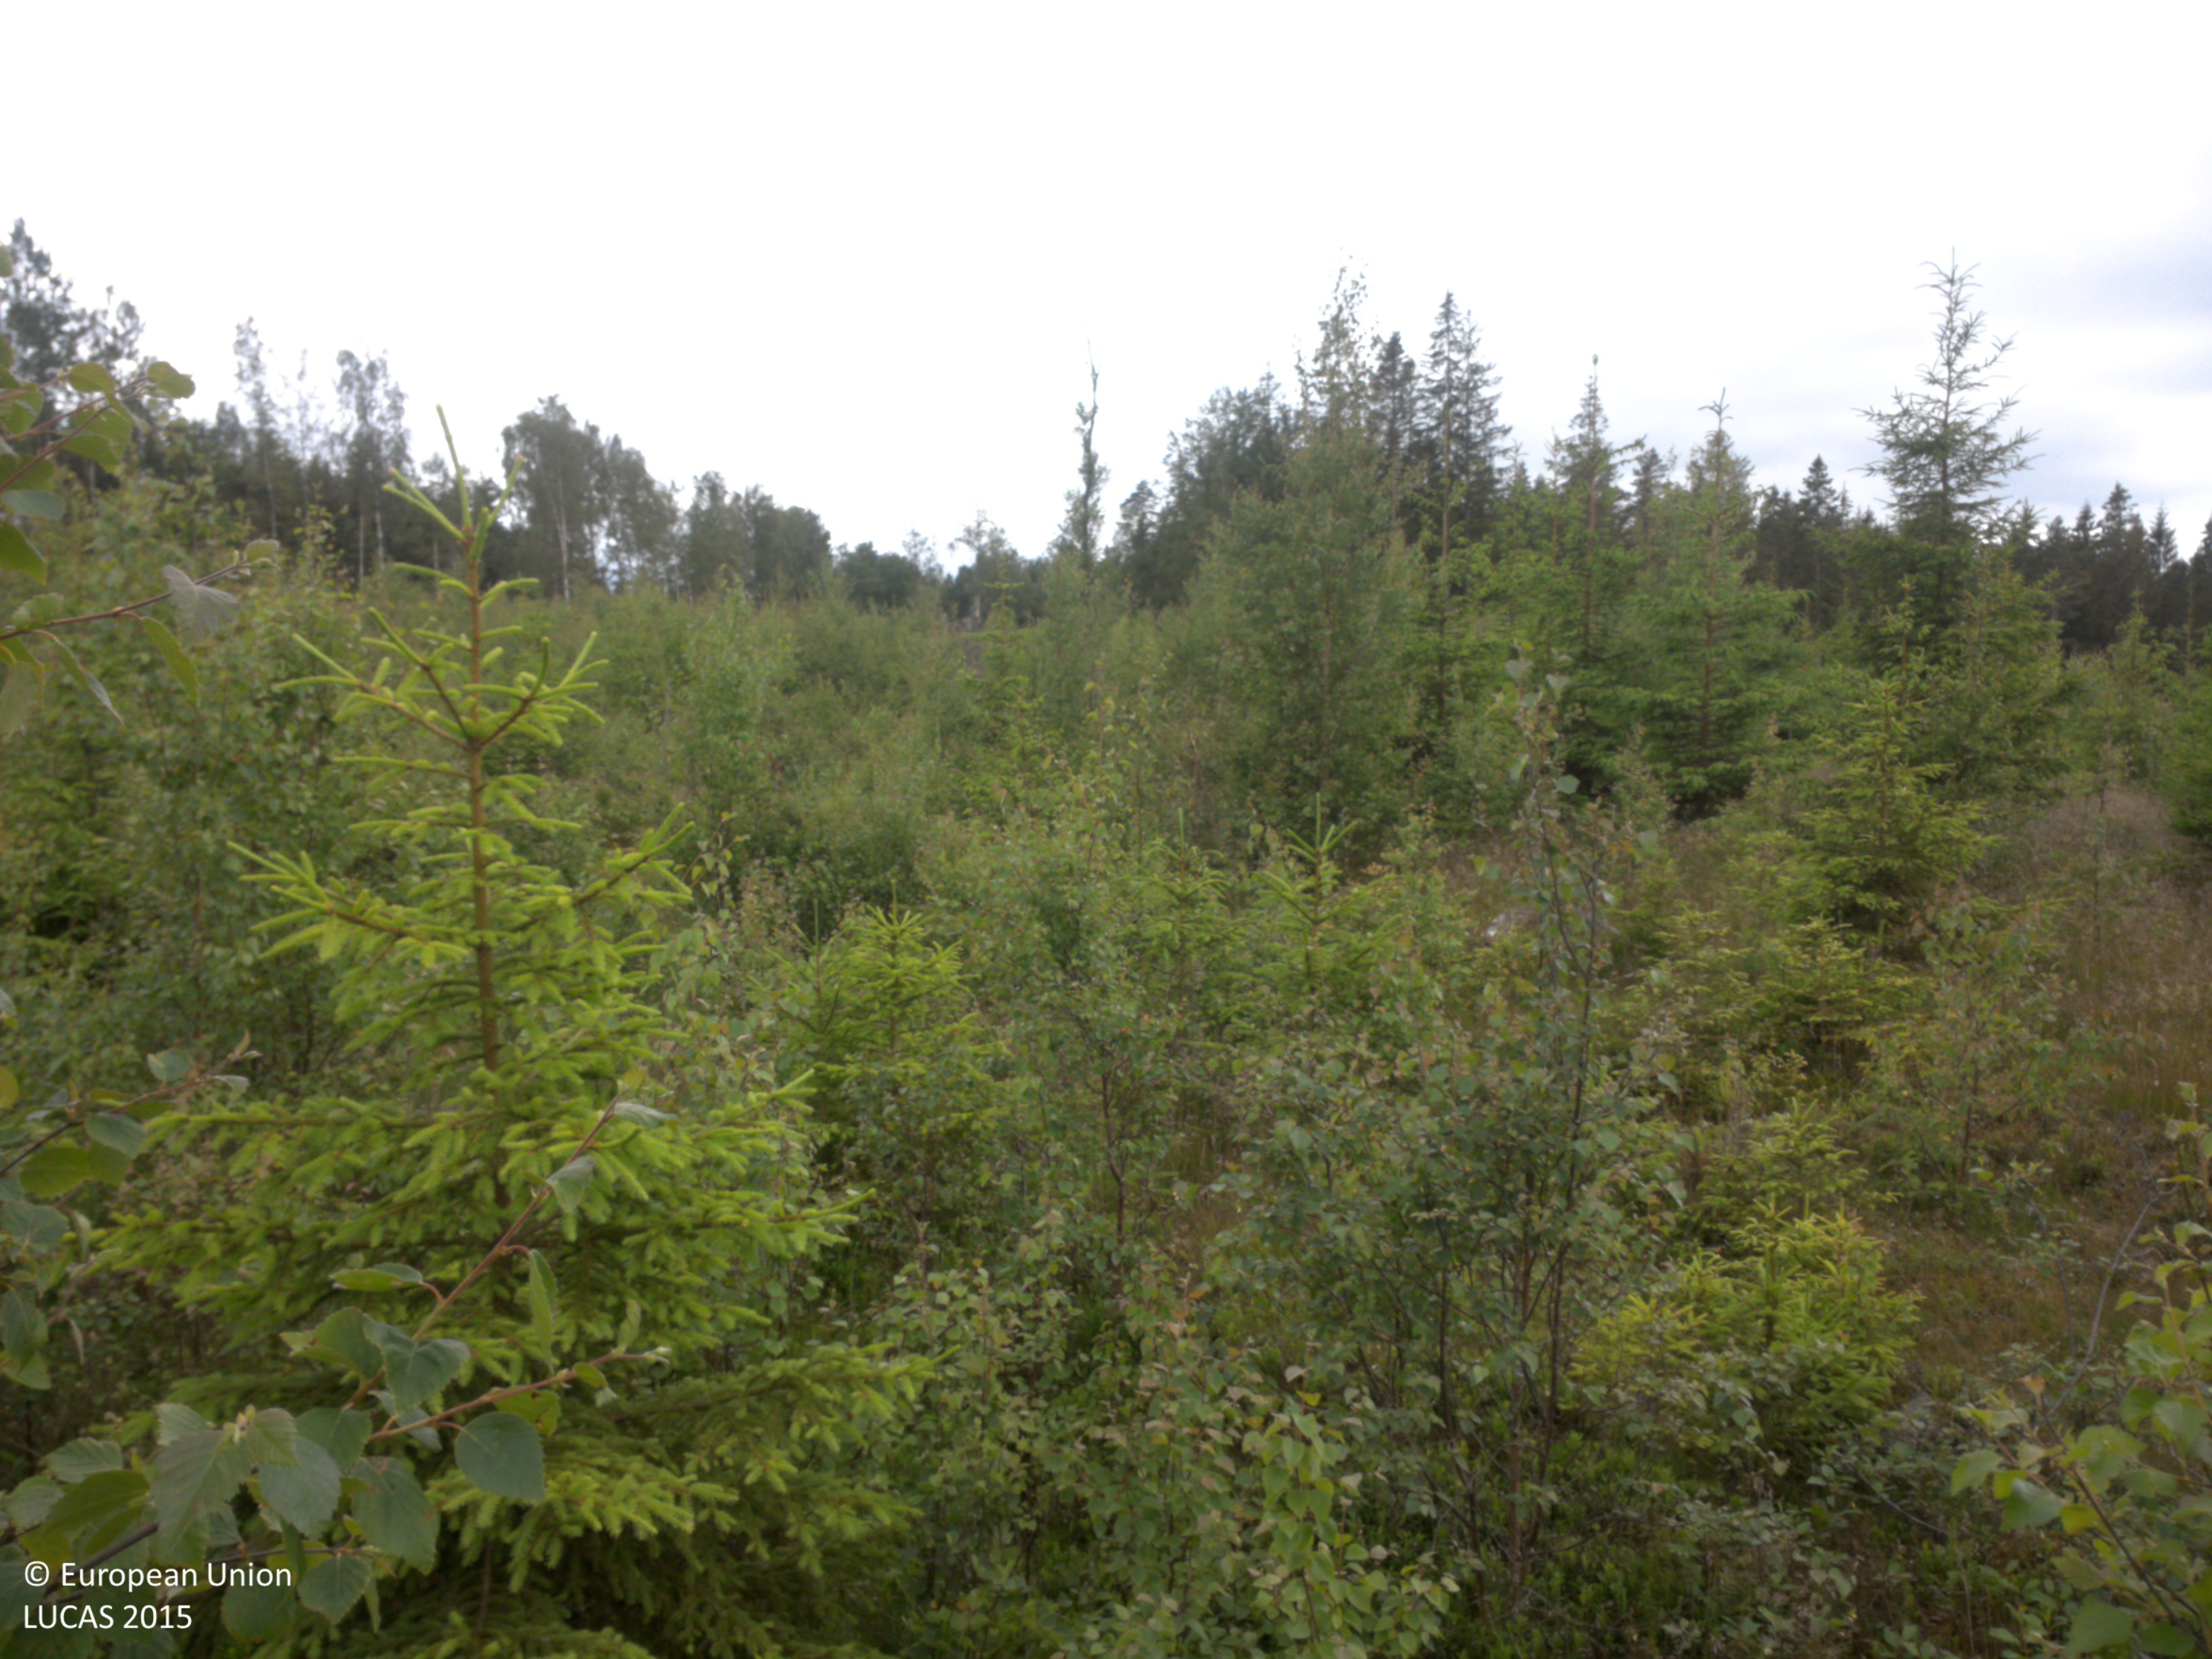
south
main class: Woodland
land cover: Spruce dominated mixed woodland
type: boreal forest
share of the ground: 50 - 75 %
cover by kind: shrubs 40 %, coniferous forest trees 30 %, broadleaved forest trees 20 %, herbaceous plants 10 %
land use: Forestry
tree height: < 5 m
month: June
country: SE
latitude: 58.9943
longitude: 12.1358
